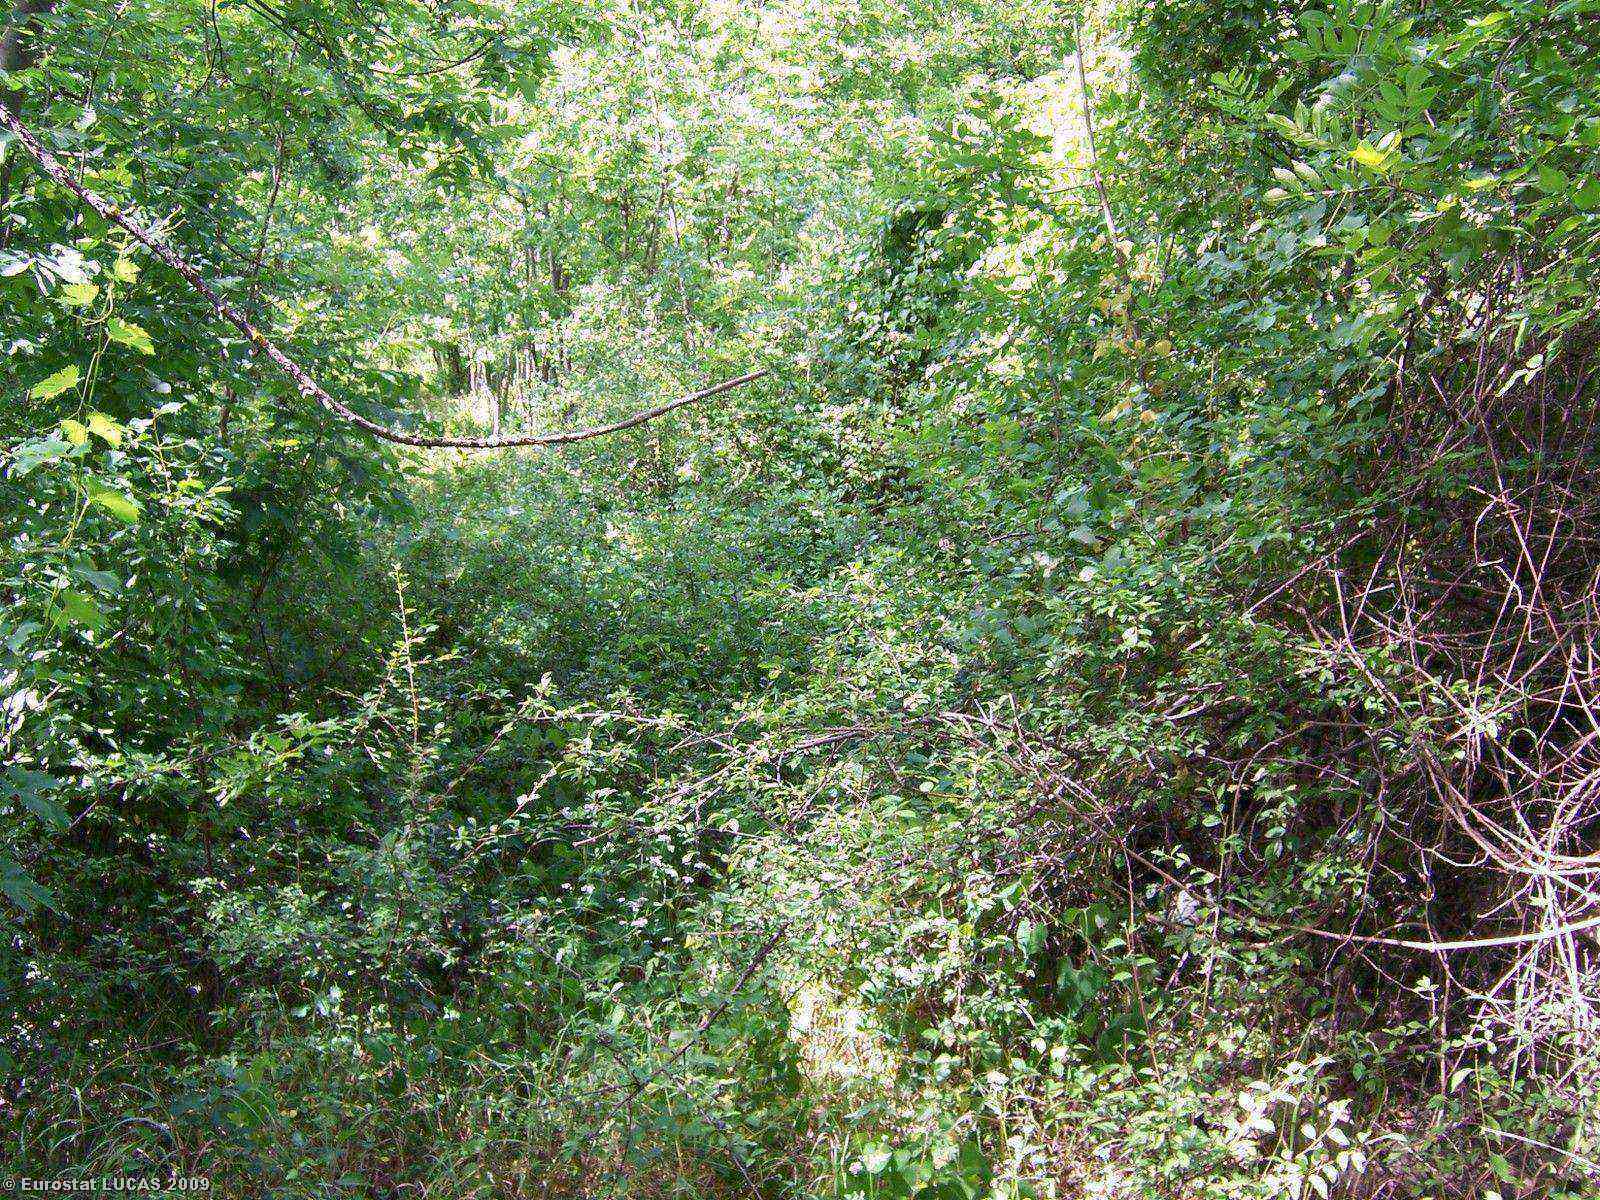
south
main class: Woodland
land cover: Broadleaved woodland
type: mesophytic deciduous forest
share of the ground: > 75 %
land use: Unused
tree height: > 5 m
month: July
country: IT
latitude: 45.1218
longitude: 7.0935
